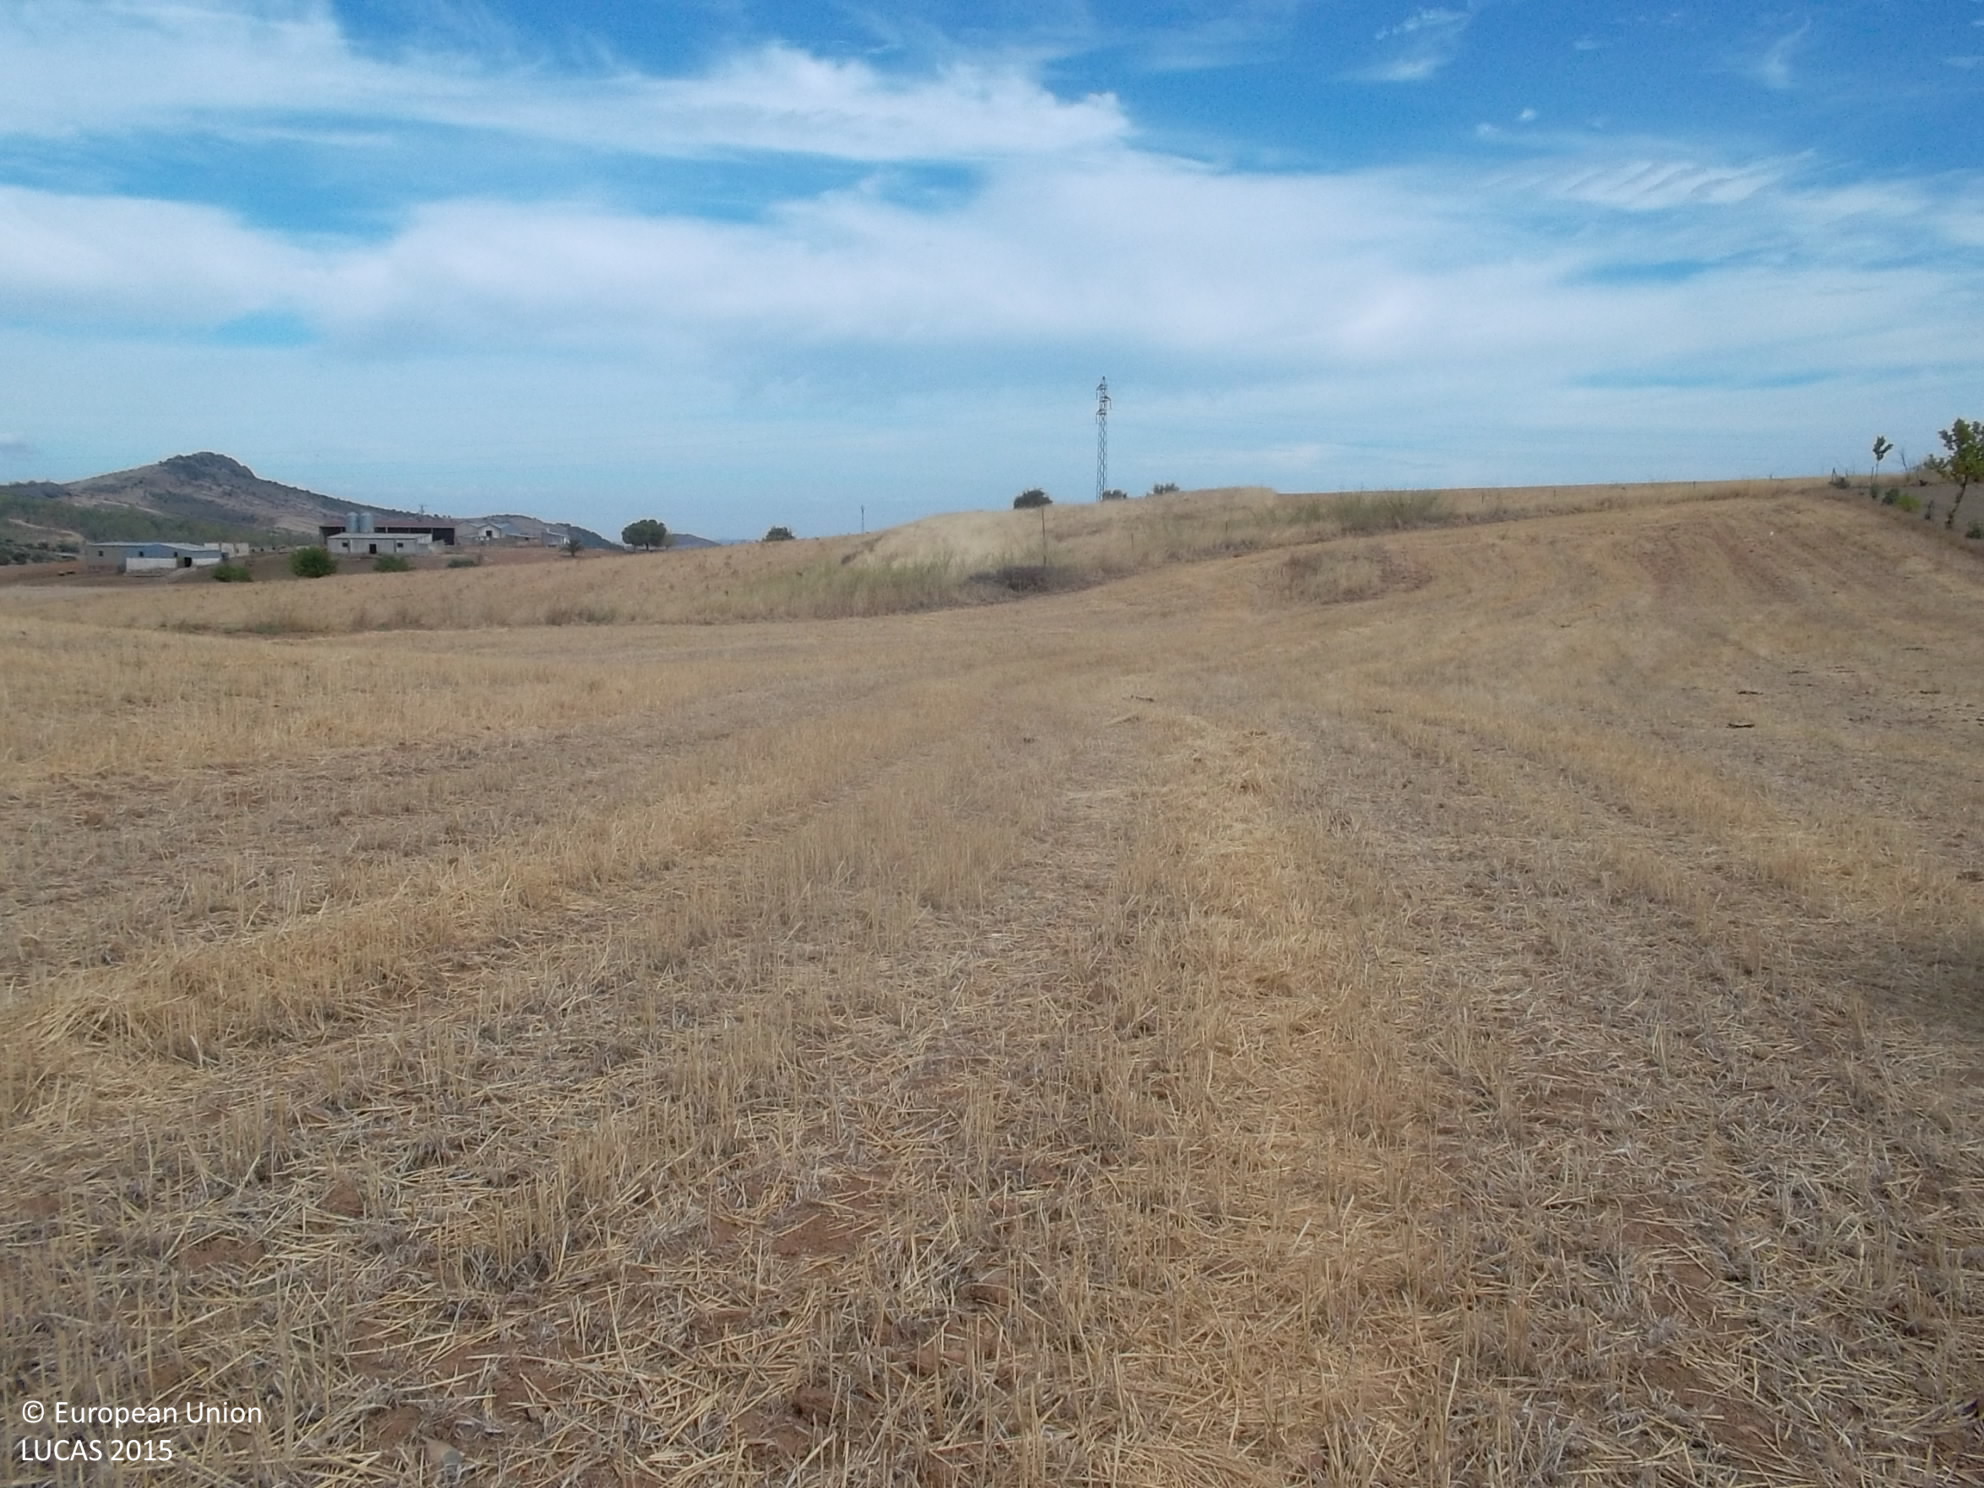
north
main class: Cropland
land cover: Common wheat
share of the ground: < 10 %
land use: Agriculture (excluding fallow land and kitchen gardens)
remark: Harvested field
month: September
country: ES
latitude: 38.3956
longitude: -6.4116
